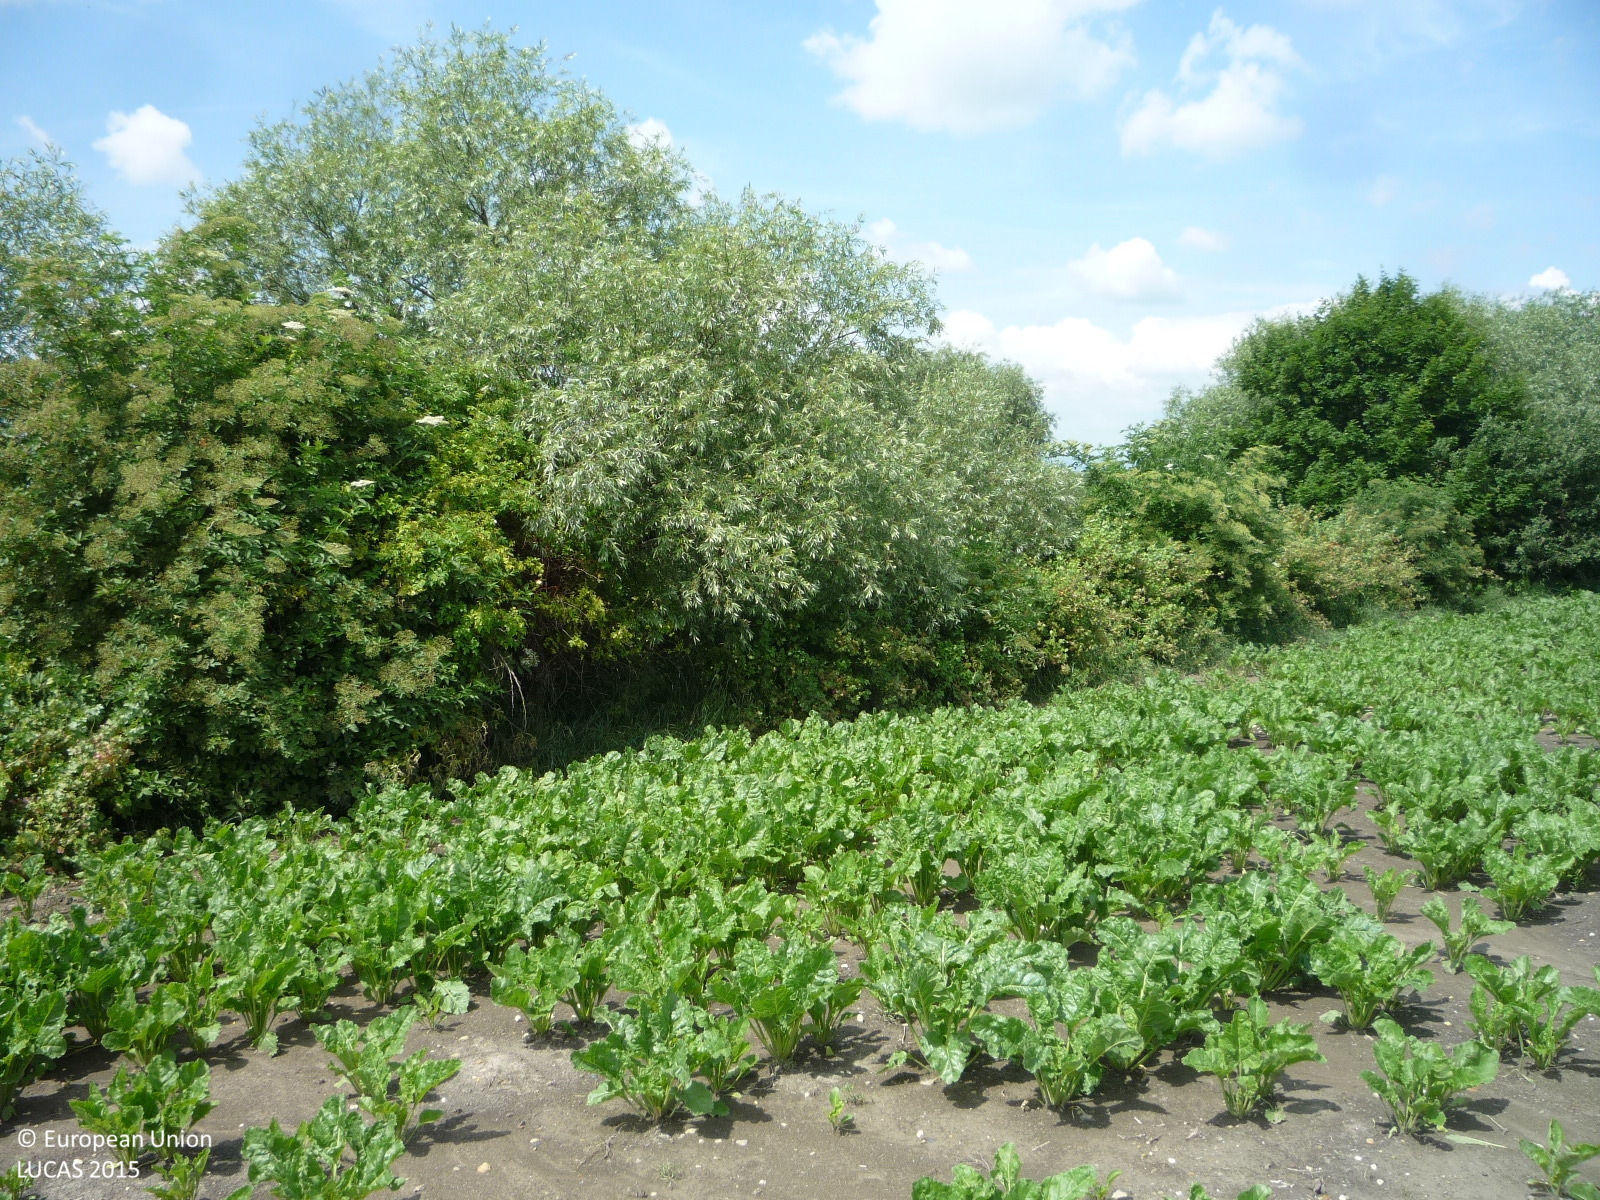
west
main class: Cropland
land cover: Sugar beet
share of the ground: > 75 %
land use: Agriculture (excluding fallow land and kitchen gardens)
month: June
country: CZ
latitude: 50.4317
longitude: 14.1824
